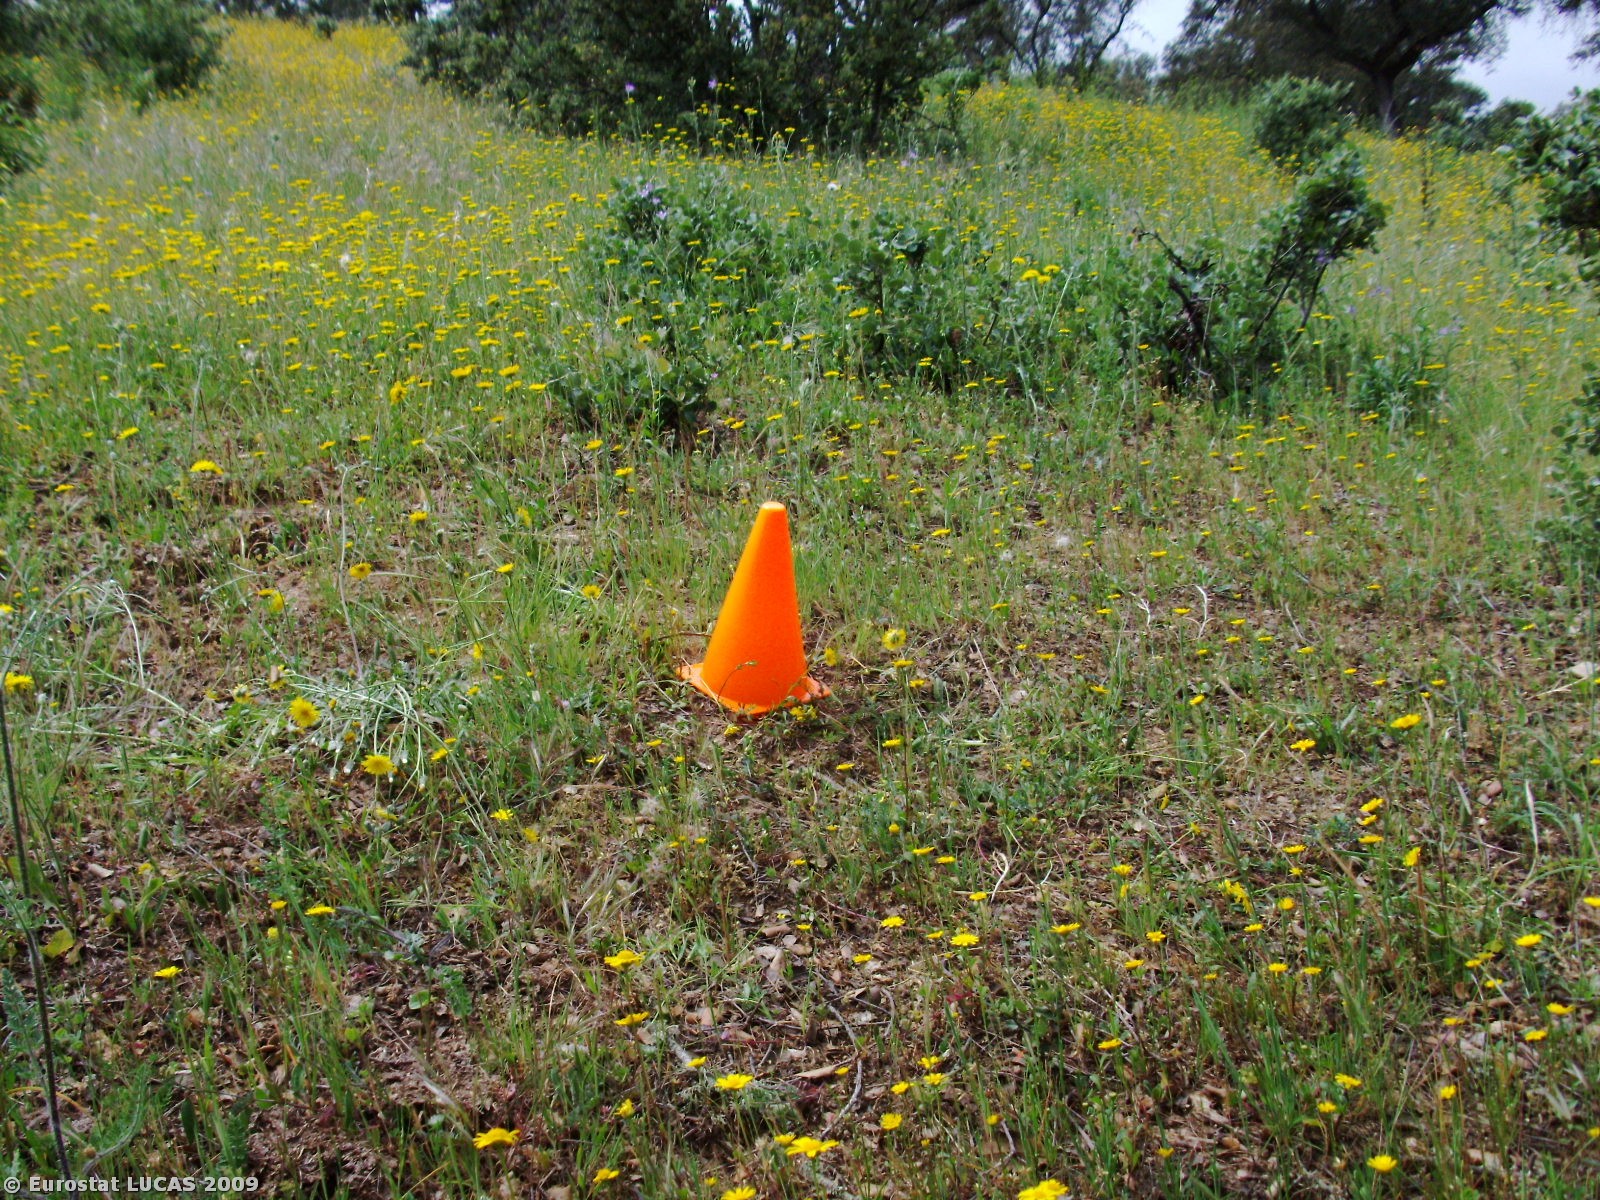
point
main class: Woodland
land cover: Broadleaved woodland
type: broadleaved evergreen forest
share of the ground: 10 - 25 %
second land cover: Spontaneously vegetated surfaces
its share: > 75 %
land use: Forestry
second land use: Fallow land
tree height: > 5 m
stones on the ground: 25 - 50 %
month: April
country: PT
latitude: 38.4953
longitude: -7.7017
